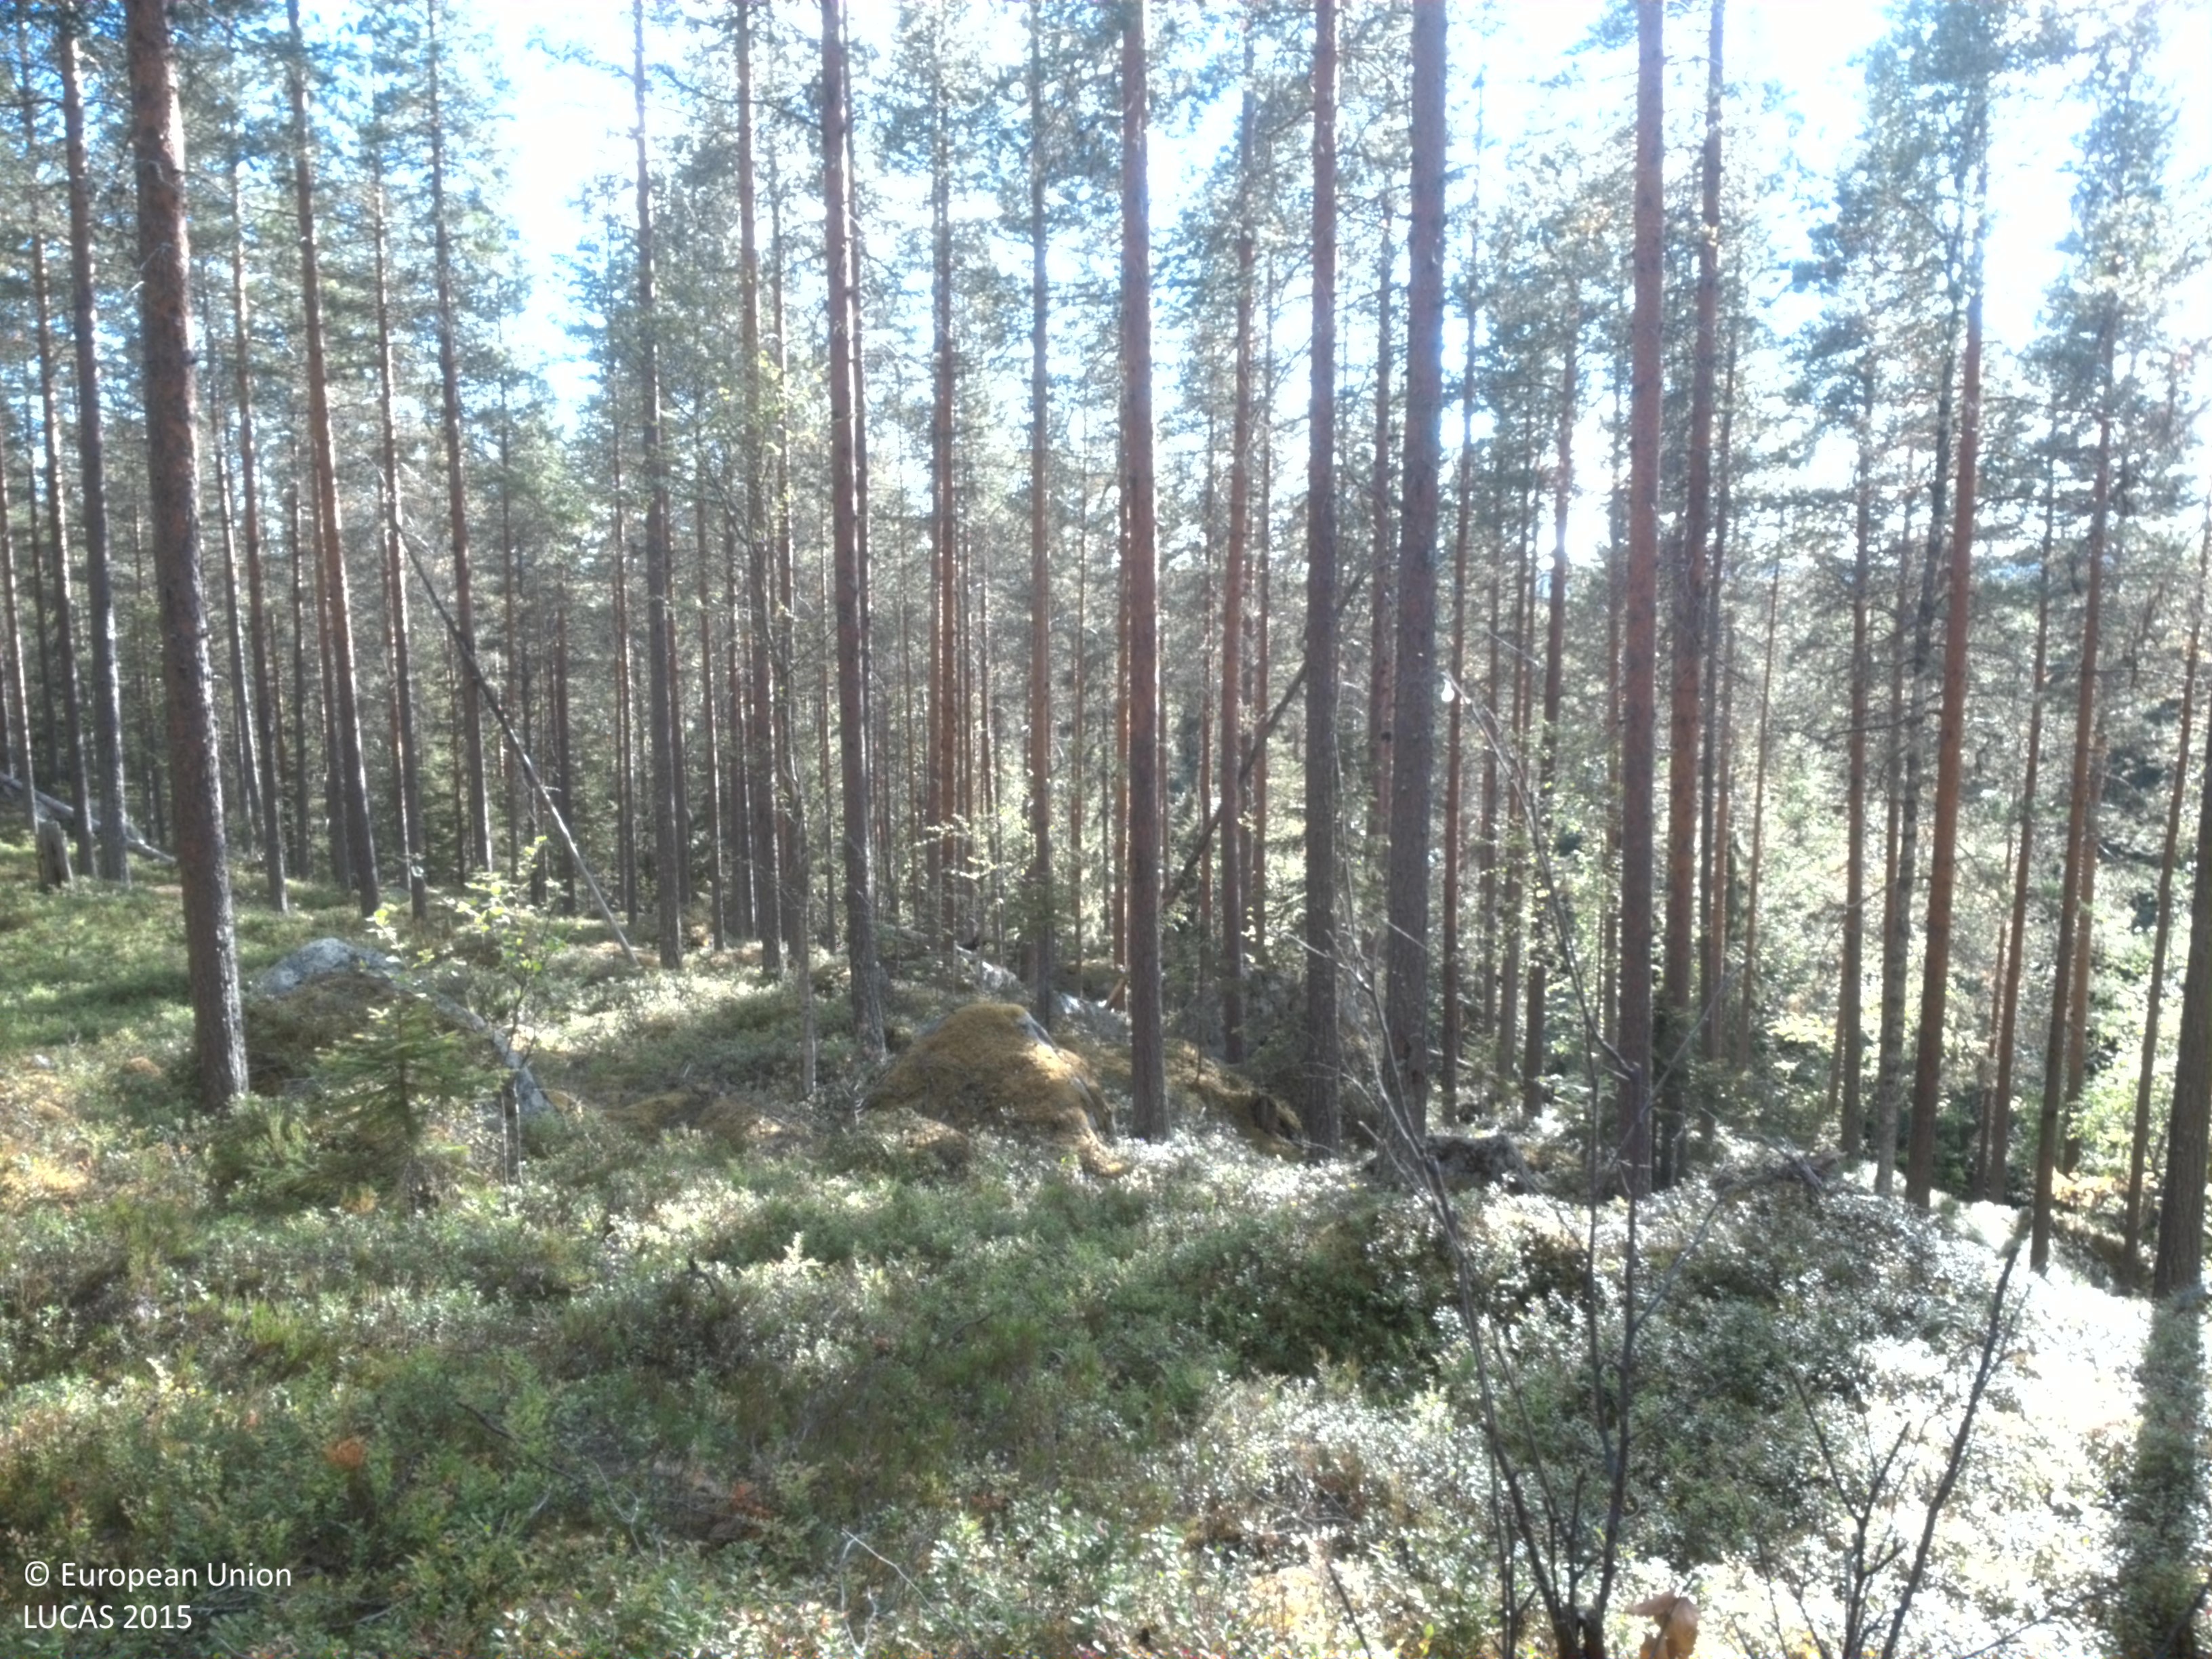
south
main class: Woodland
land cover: Pine dominated coniferous woodland
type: boreal forest
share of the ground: 50 - 75 %
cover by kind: coniferous forest trees 55 %, shrubs 30 %, lichens and mosses 15 %
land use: Forestry
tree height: > 5 m
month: September
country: SE
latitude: 64.4107
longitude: 19.0803
